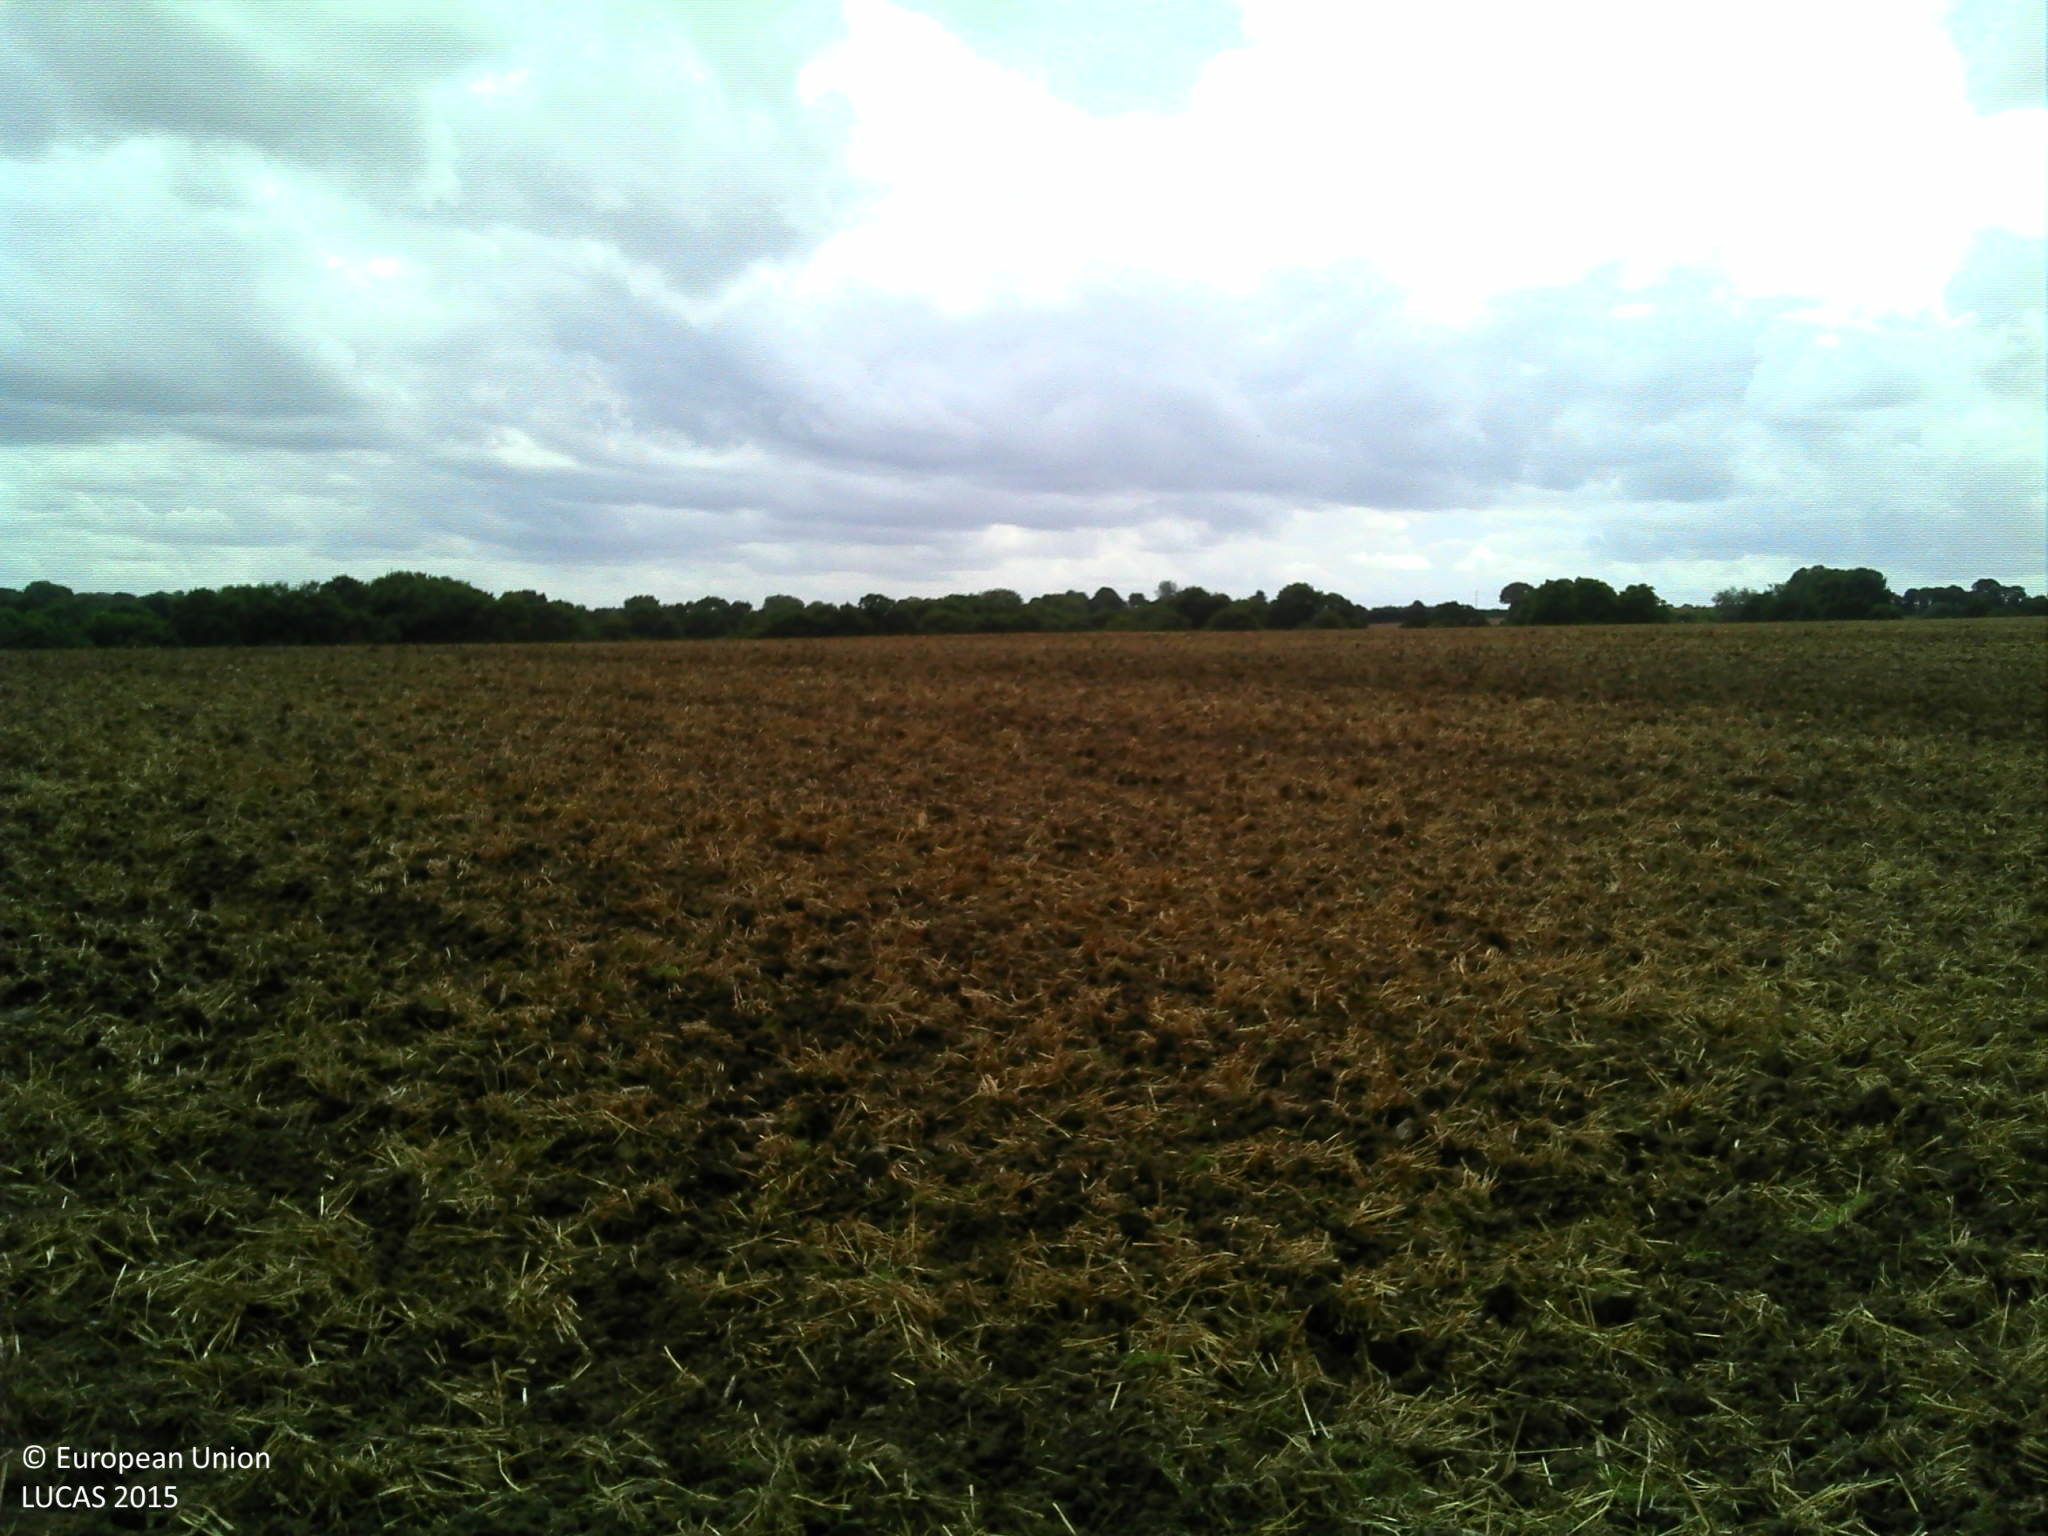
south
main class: Cropland
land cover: Maize
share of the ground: > 75 %
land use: Agriculture (excluding fallow land and kitchen gardens)
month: August
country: FR
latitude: 48.2954
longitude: -3.2429
